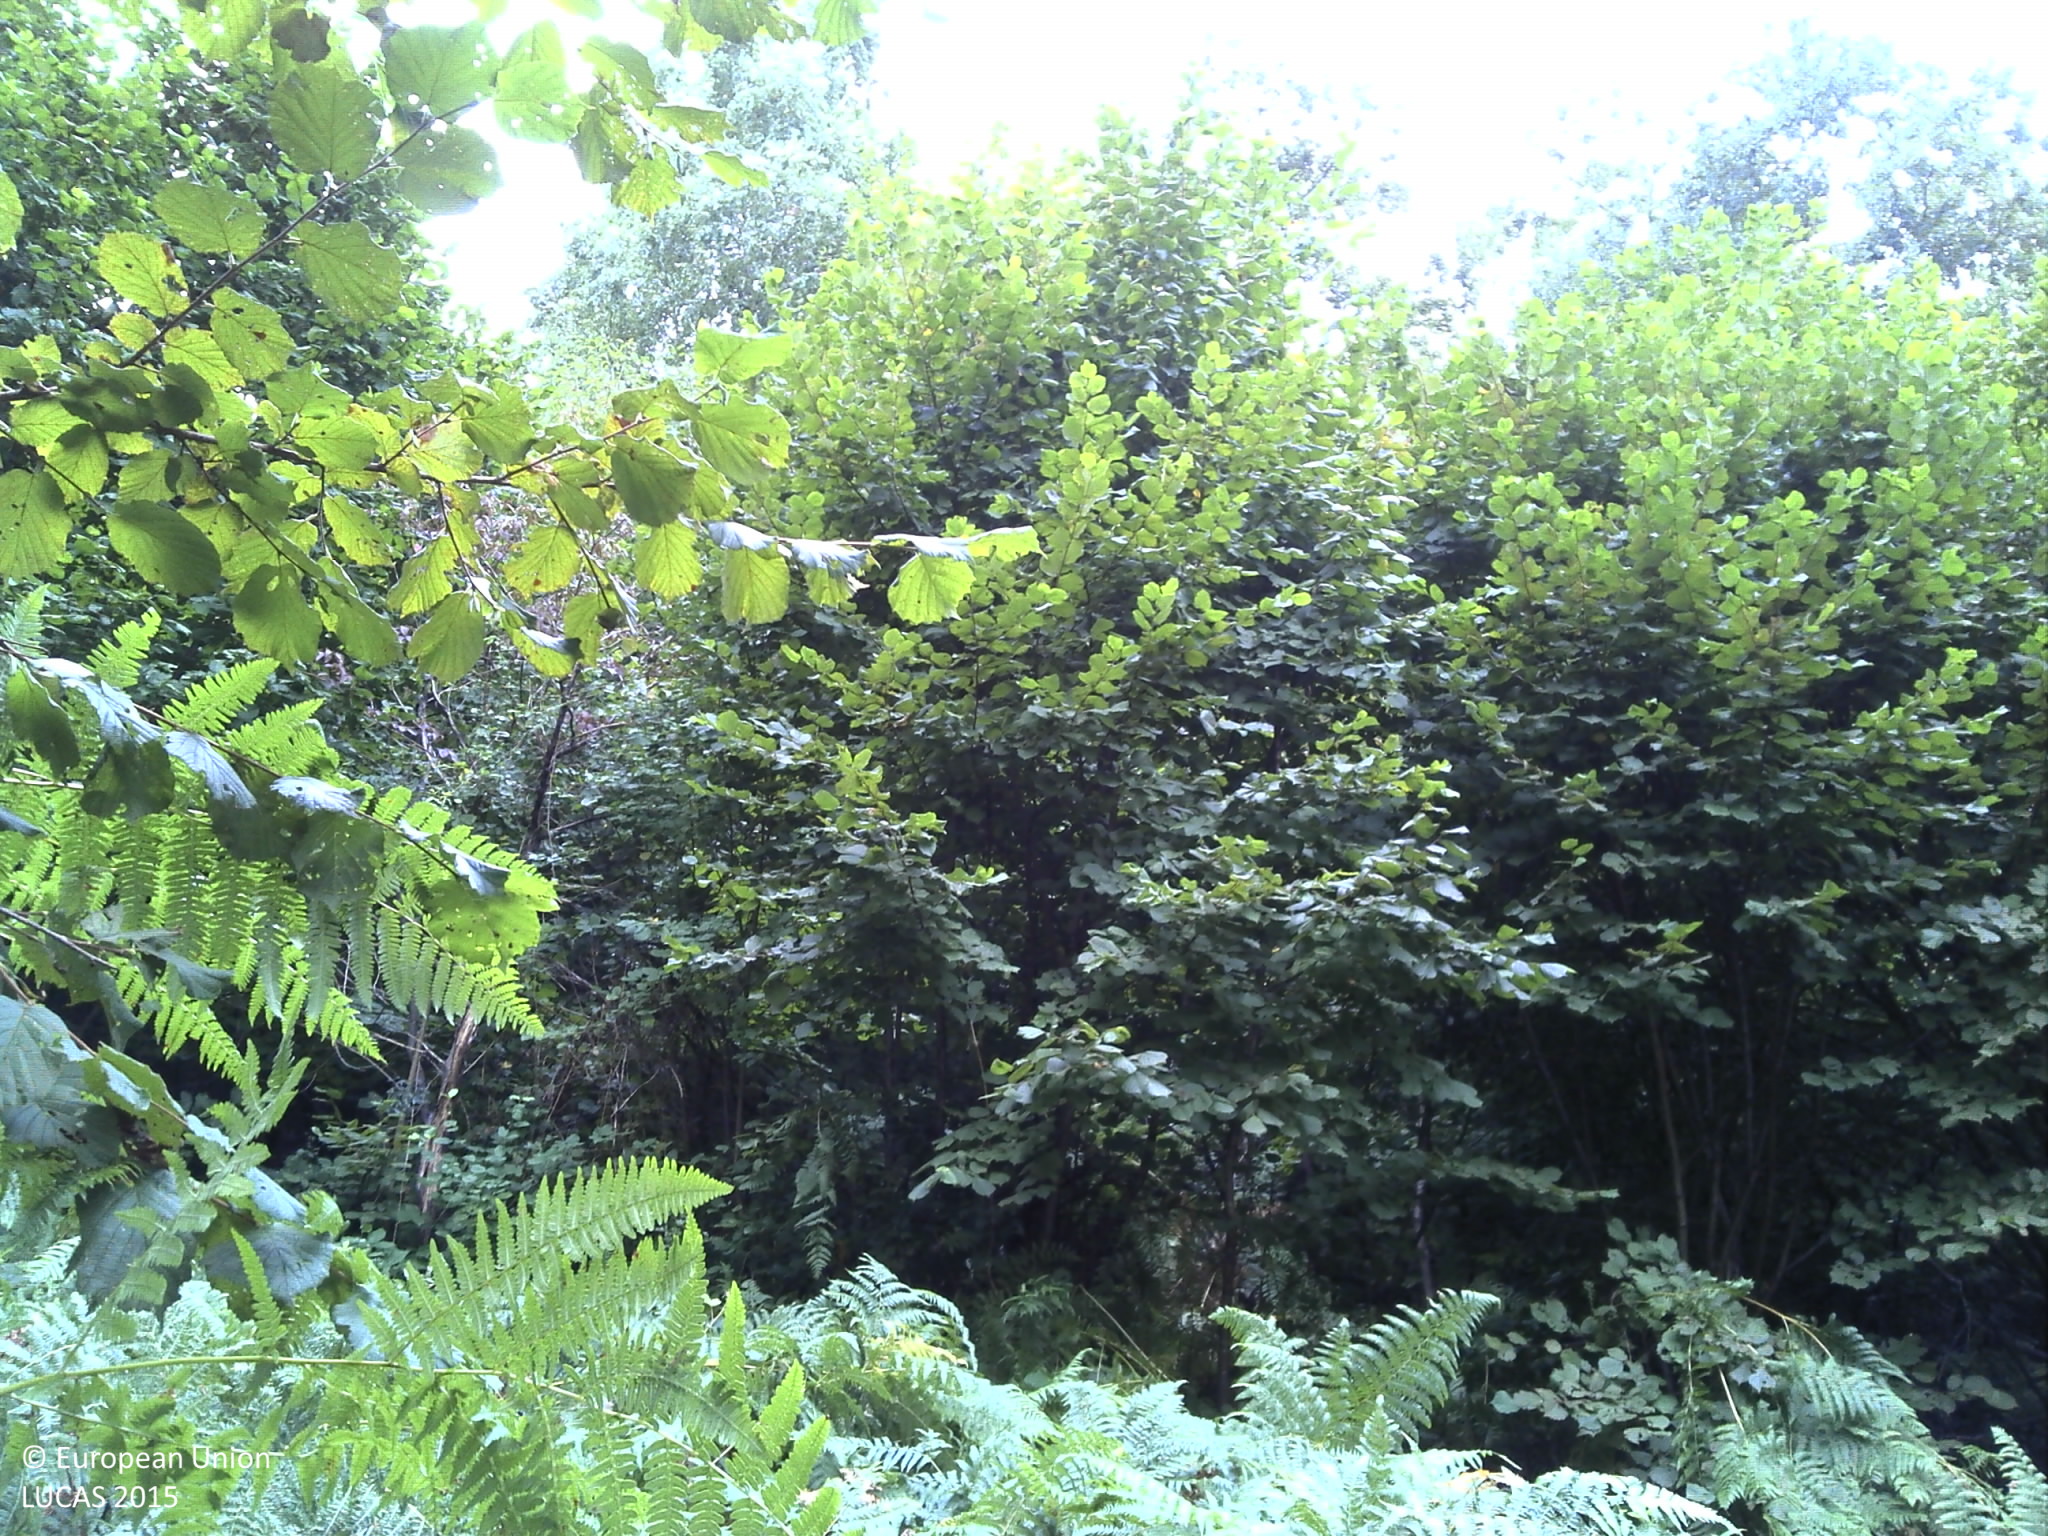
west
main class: Woodland
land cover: Broadleaved woodland
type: mesophytic deciduous forest
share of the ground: 50 - 75 %
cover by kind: broadleaved forest trees 75 %, shrubs 20 %, herbaceous plants 5 %
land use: Semi-natural and natural areas not in use
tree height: > 5 m
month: August
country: HR
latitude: 45.3337
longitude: 15.6743
